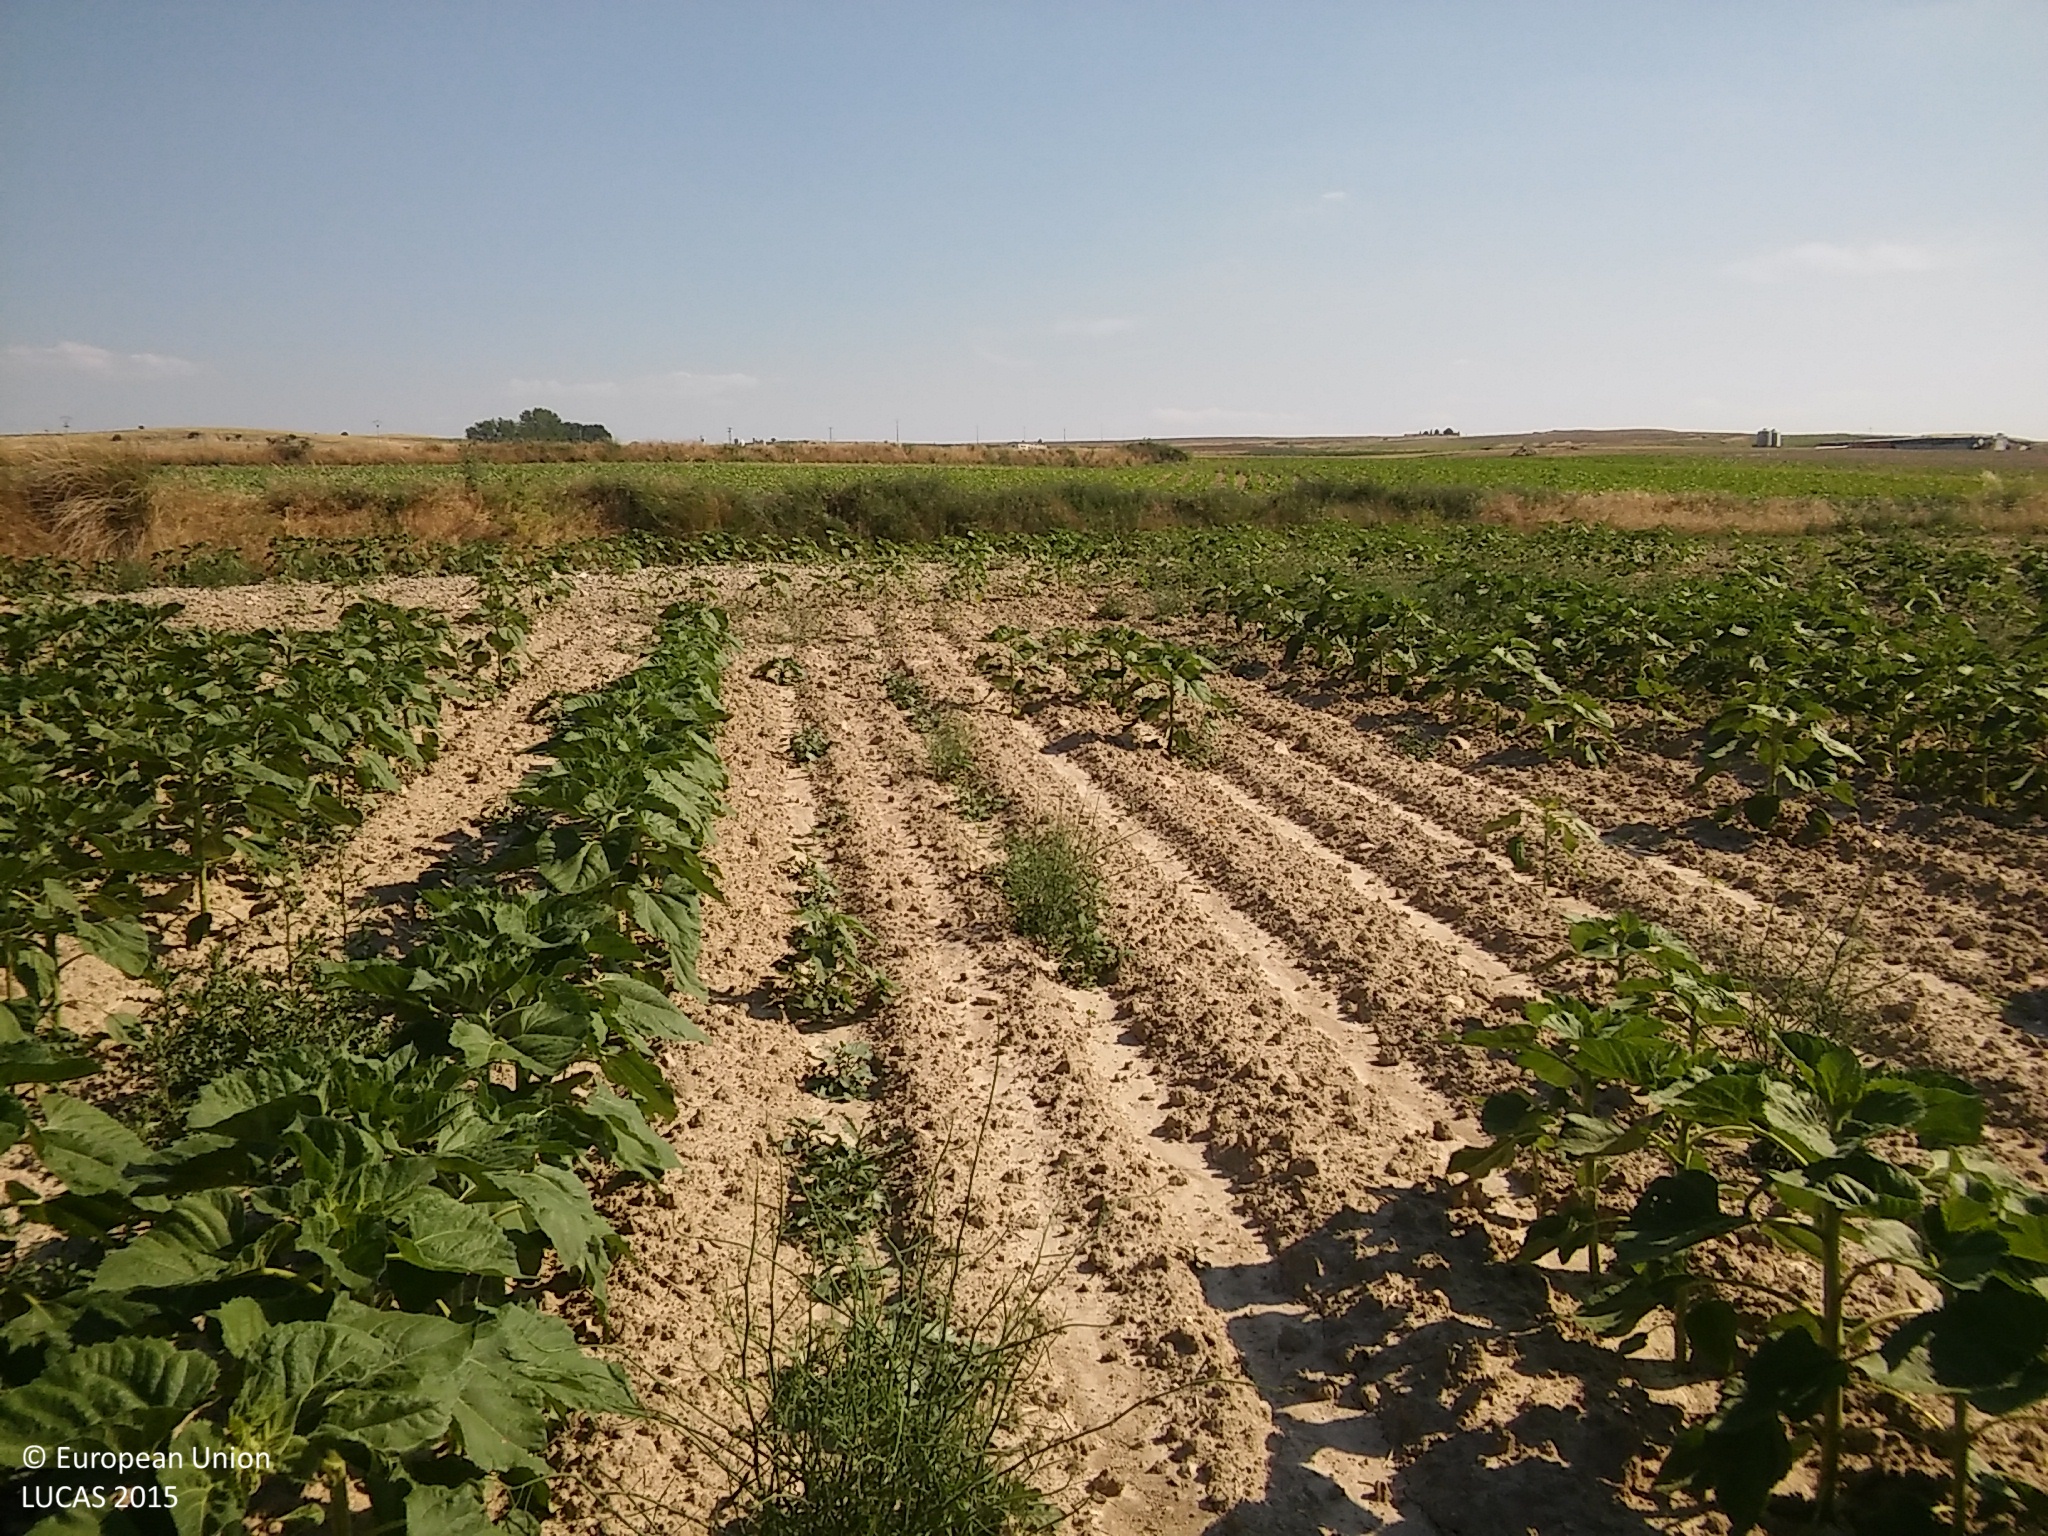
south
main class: Cropland
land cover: Sunflower
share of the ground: 50 - 75 %
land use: Agriculture (excluding fallow land and kitchen gardens)
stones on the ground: 10 - 25 %
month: June
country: ES
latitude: 41.1238
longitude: -4.0224
